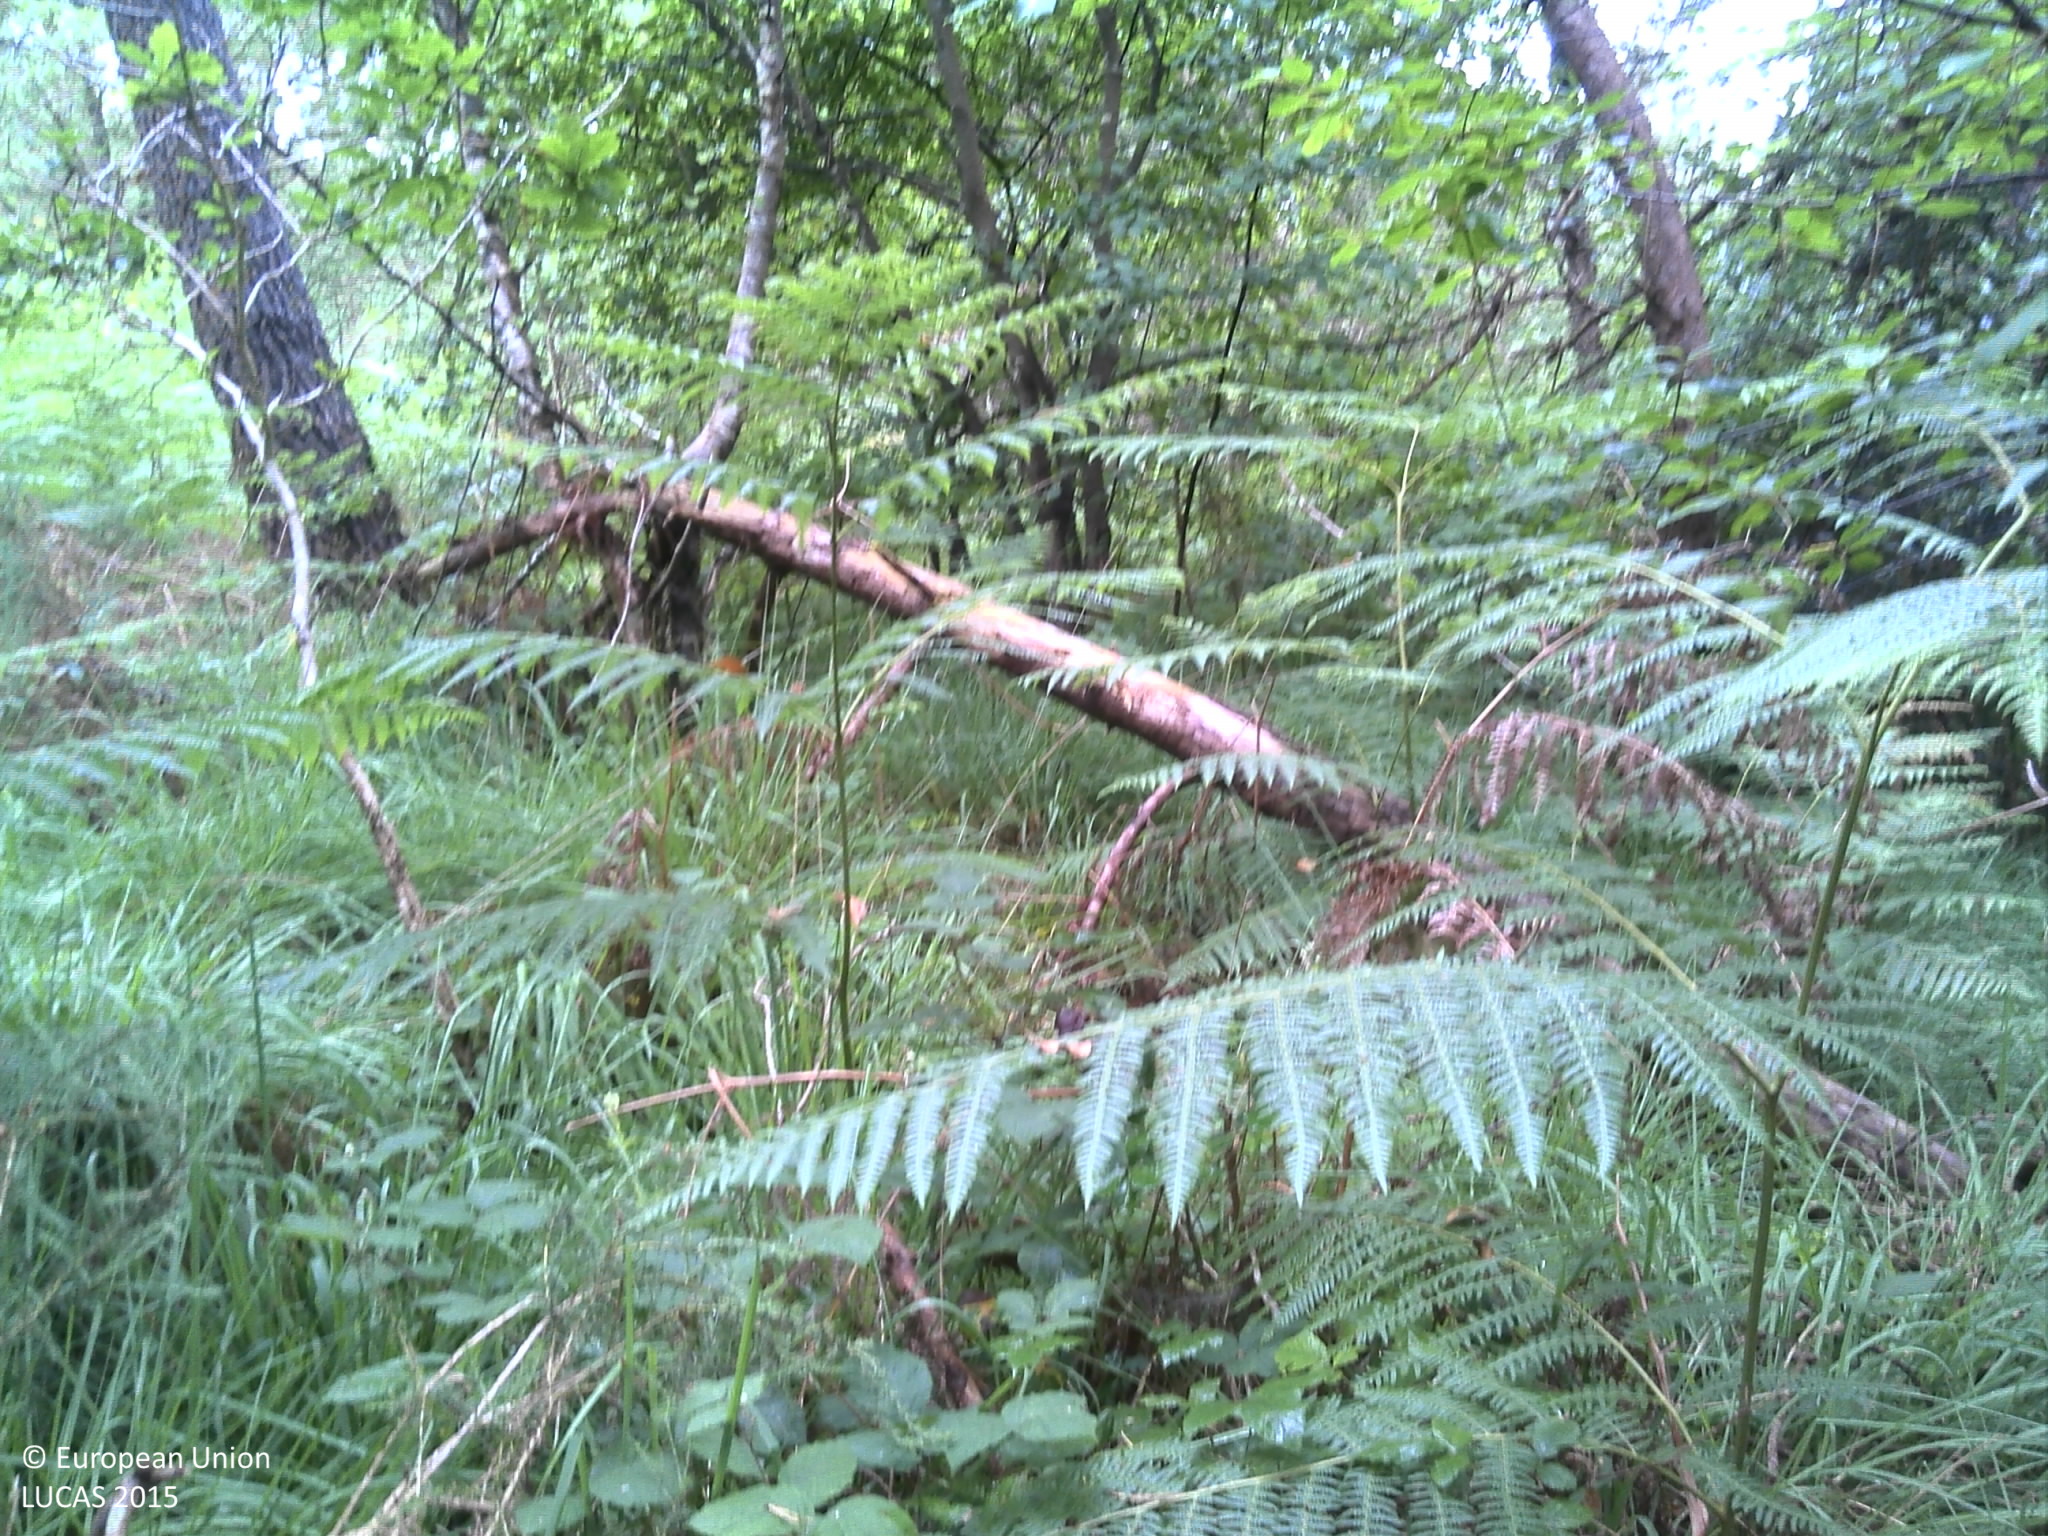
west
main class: Woodland
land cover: Pine dominated mixed woodland
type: hemiboreal forest and nemoral coniferous forest and mixed broadleaved-coniferous forest
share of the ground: > 75 %
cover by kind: coniferous forest trees 50 %, broadleaved forest trees 25 %, herbaceous plants 10 %, shrubs 5 %, lichens and mosses 5 %, consolidated bare surface 5 %
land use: Forestry
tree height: > 5 m
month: July
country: FR
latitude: 48.1966
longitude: -4.1768
